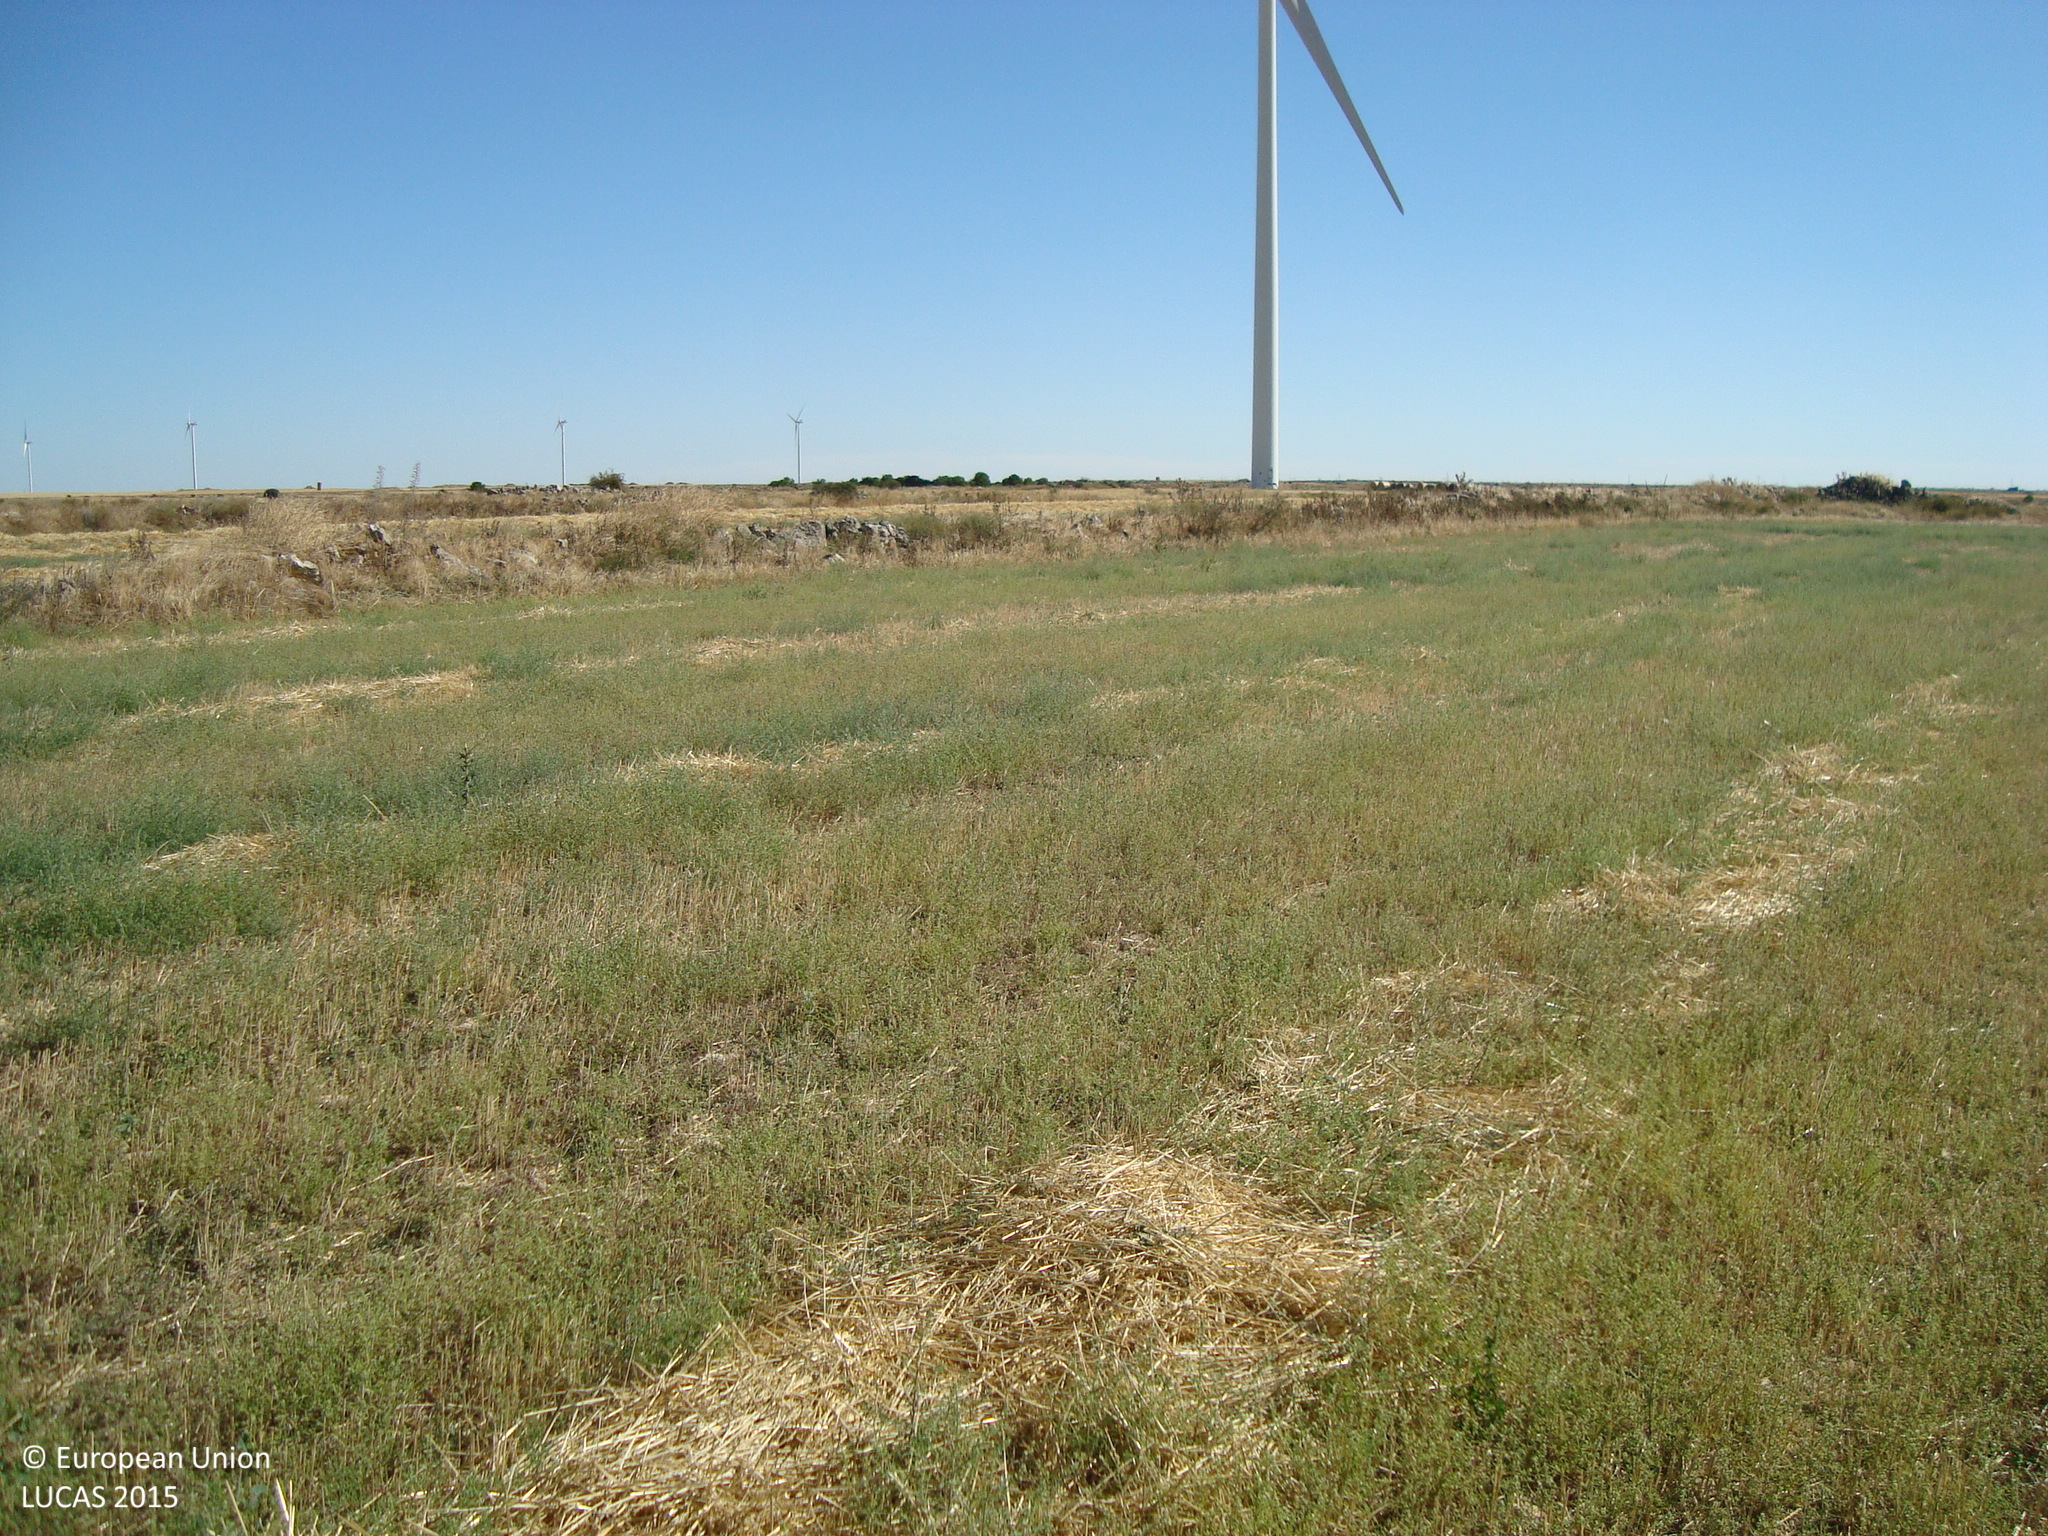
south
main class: Cropland
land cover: Barley
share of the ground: > 75 %
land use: Agriculture (excluding fallow land and kitchen gardens)
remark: Harvested field
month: August
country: ES
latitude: 42.2216
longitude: -4.1560
